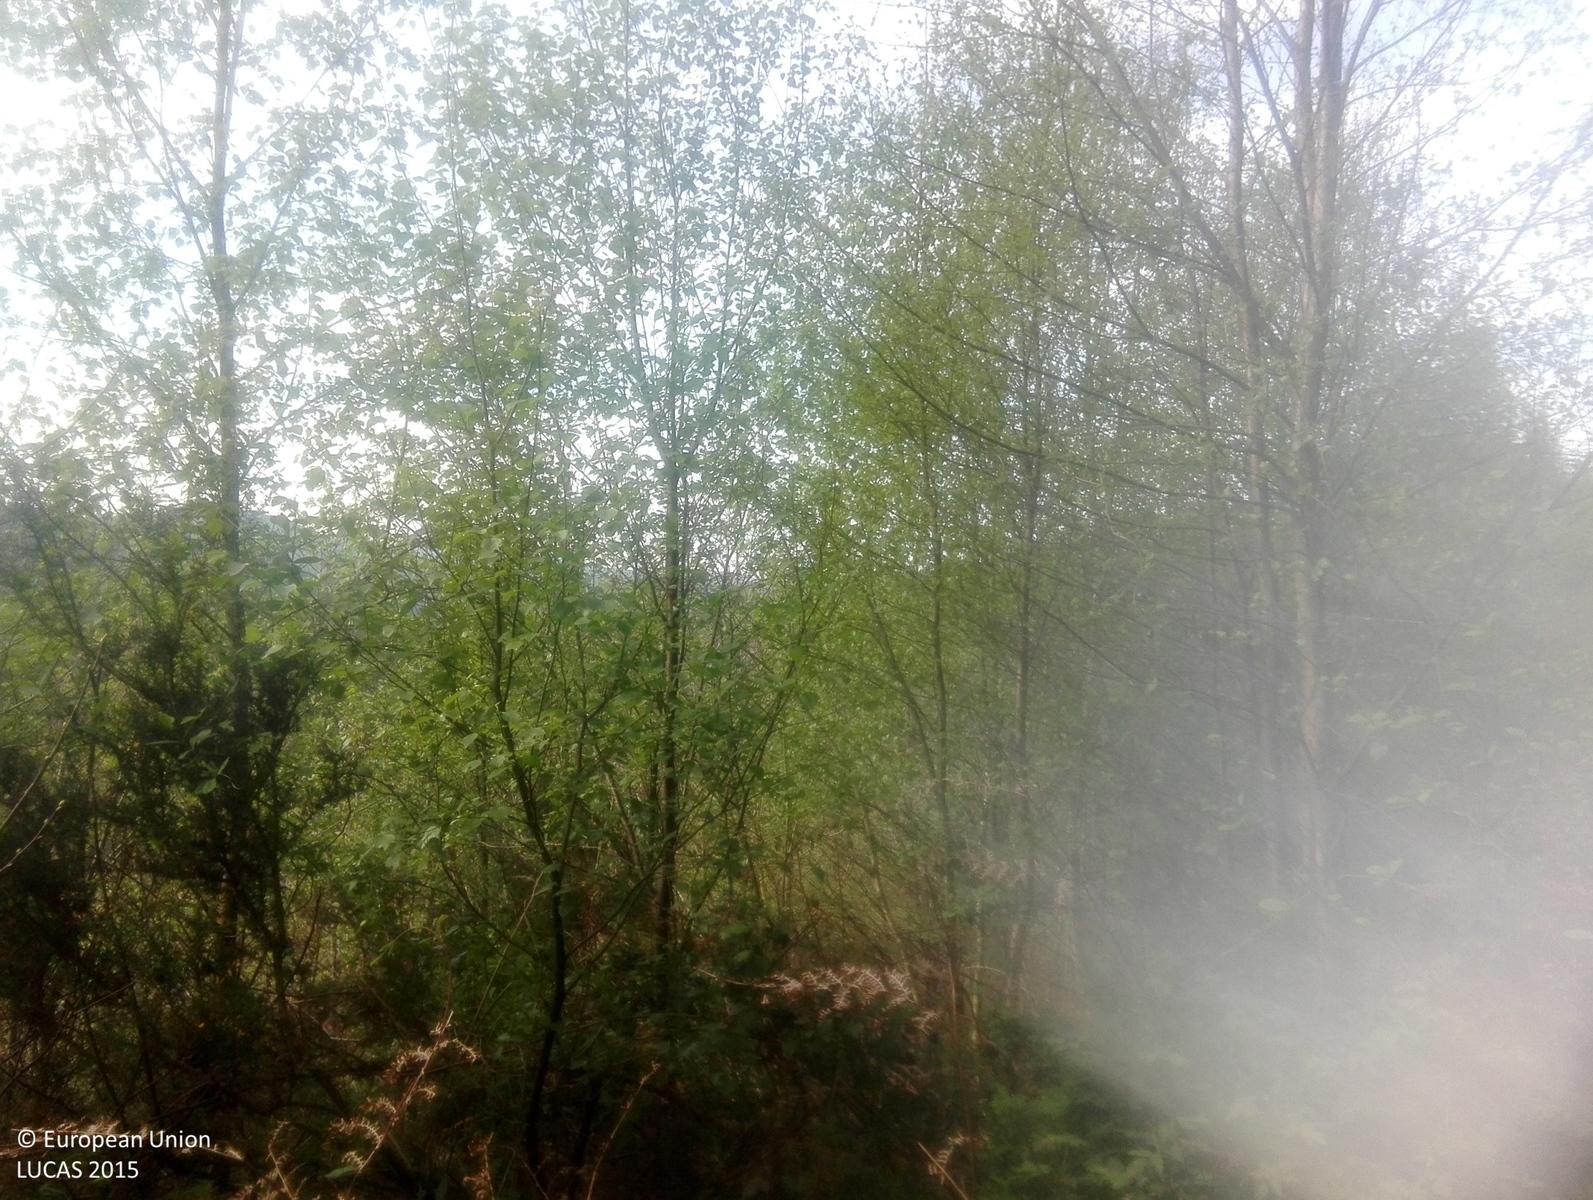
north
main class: Woodland
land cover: Broadleaved woodland
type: thermophilous deciduous forest
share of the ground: > 75 %
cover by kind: broadleaved forest trees 100 %
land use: Forestry
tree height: > 5 m
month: April
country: ES
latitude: 43.3976
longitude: -7.0953
